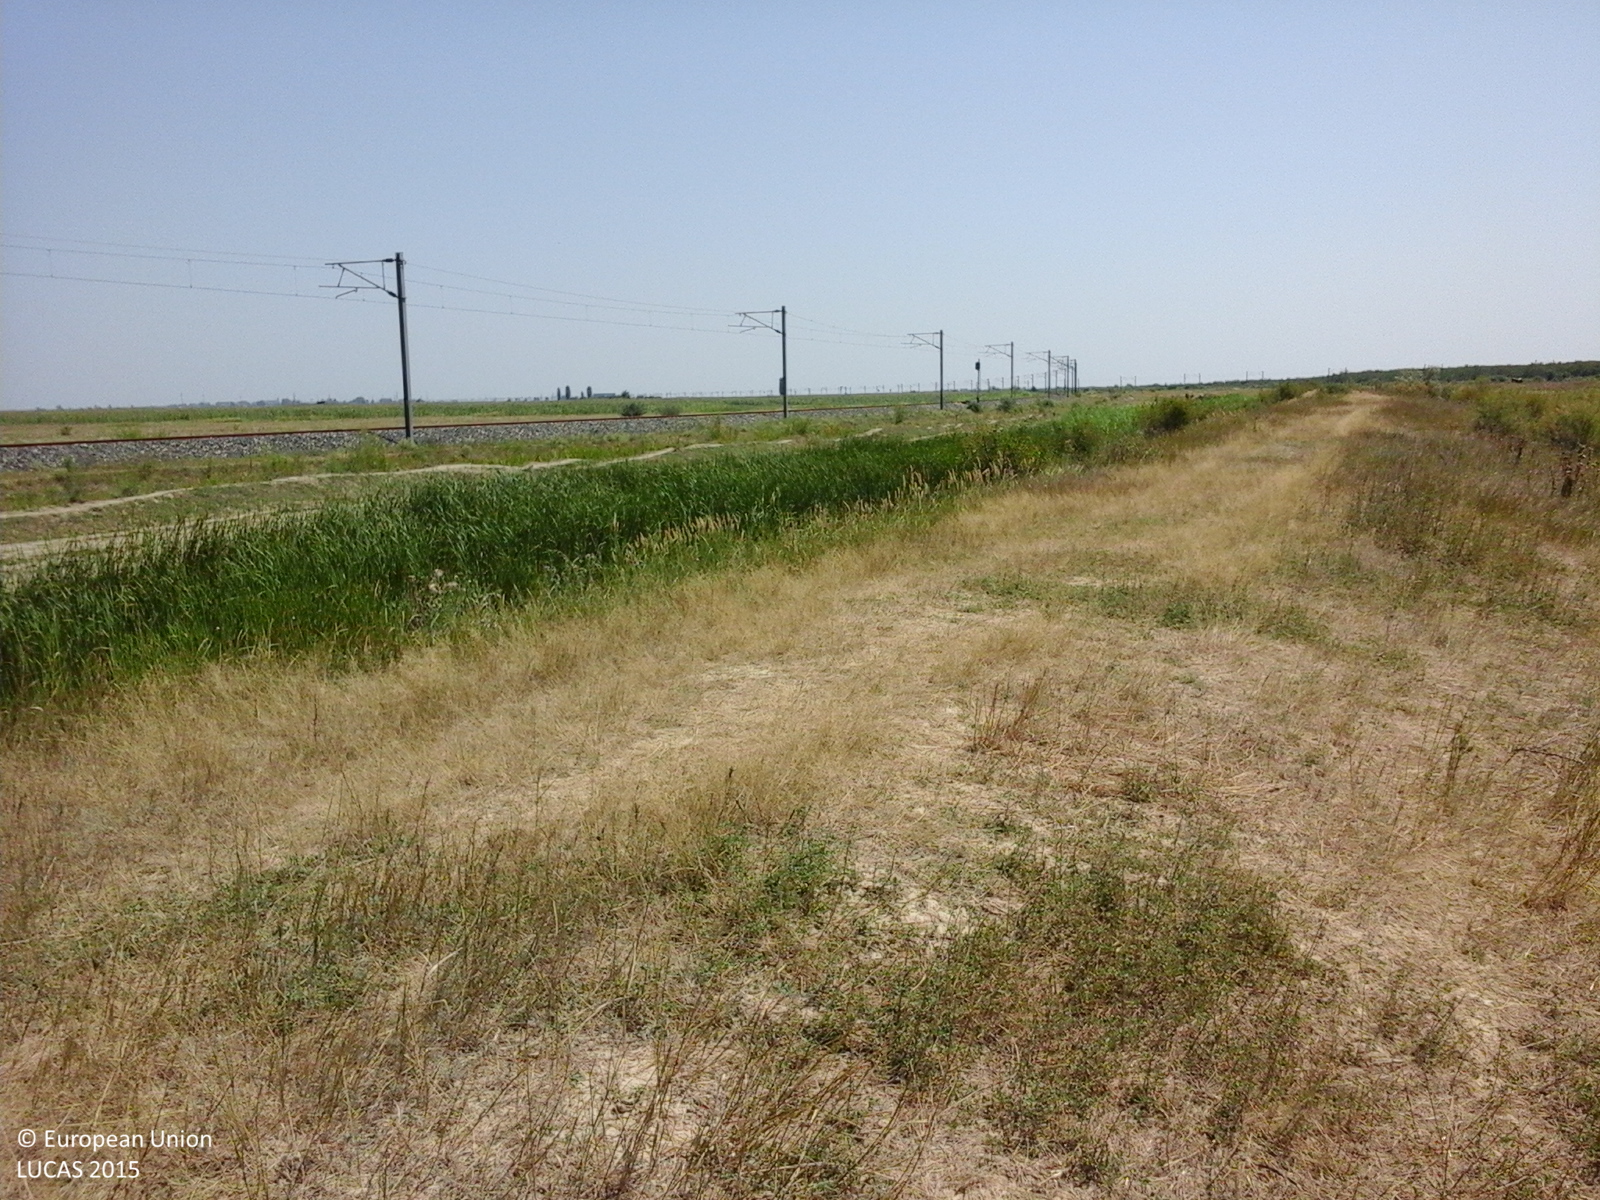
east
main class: Grassland
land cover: Spontaneously vegetated surfaces
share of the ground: > 75 %
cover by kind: herbaceous plants 100 %
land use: Fallow land
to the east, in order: Spontaneously vegetated surfaces; Tracks; Grassland without tree/shrub cover; Ditches and canals; Grassland without tree/shrub cover; Ditches and canals; Grassland without tree/shrub cover; Railways; Grassland without tree/shrub cover; Ditches and canals; Grassland without tree/shrub cover
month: July
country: RO
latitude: 45.0733
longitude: 27.1993
